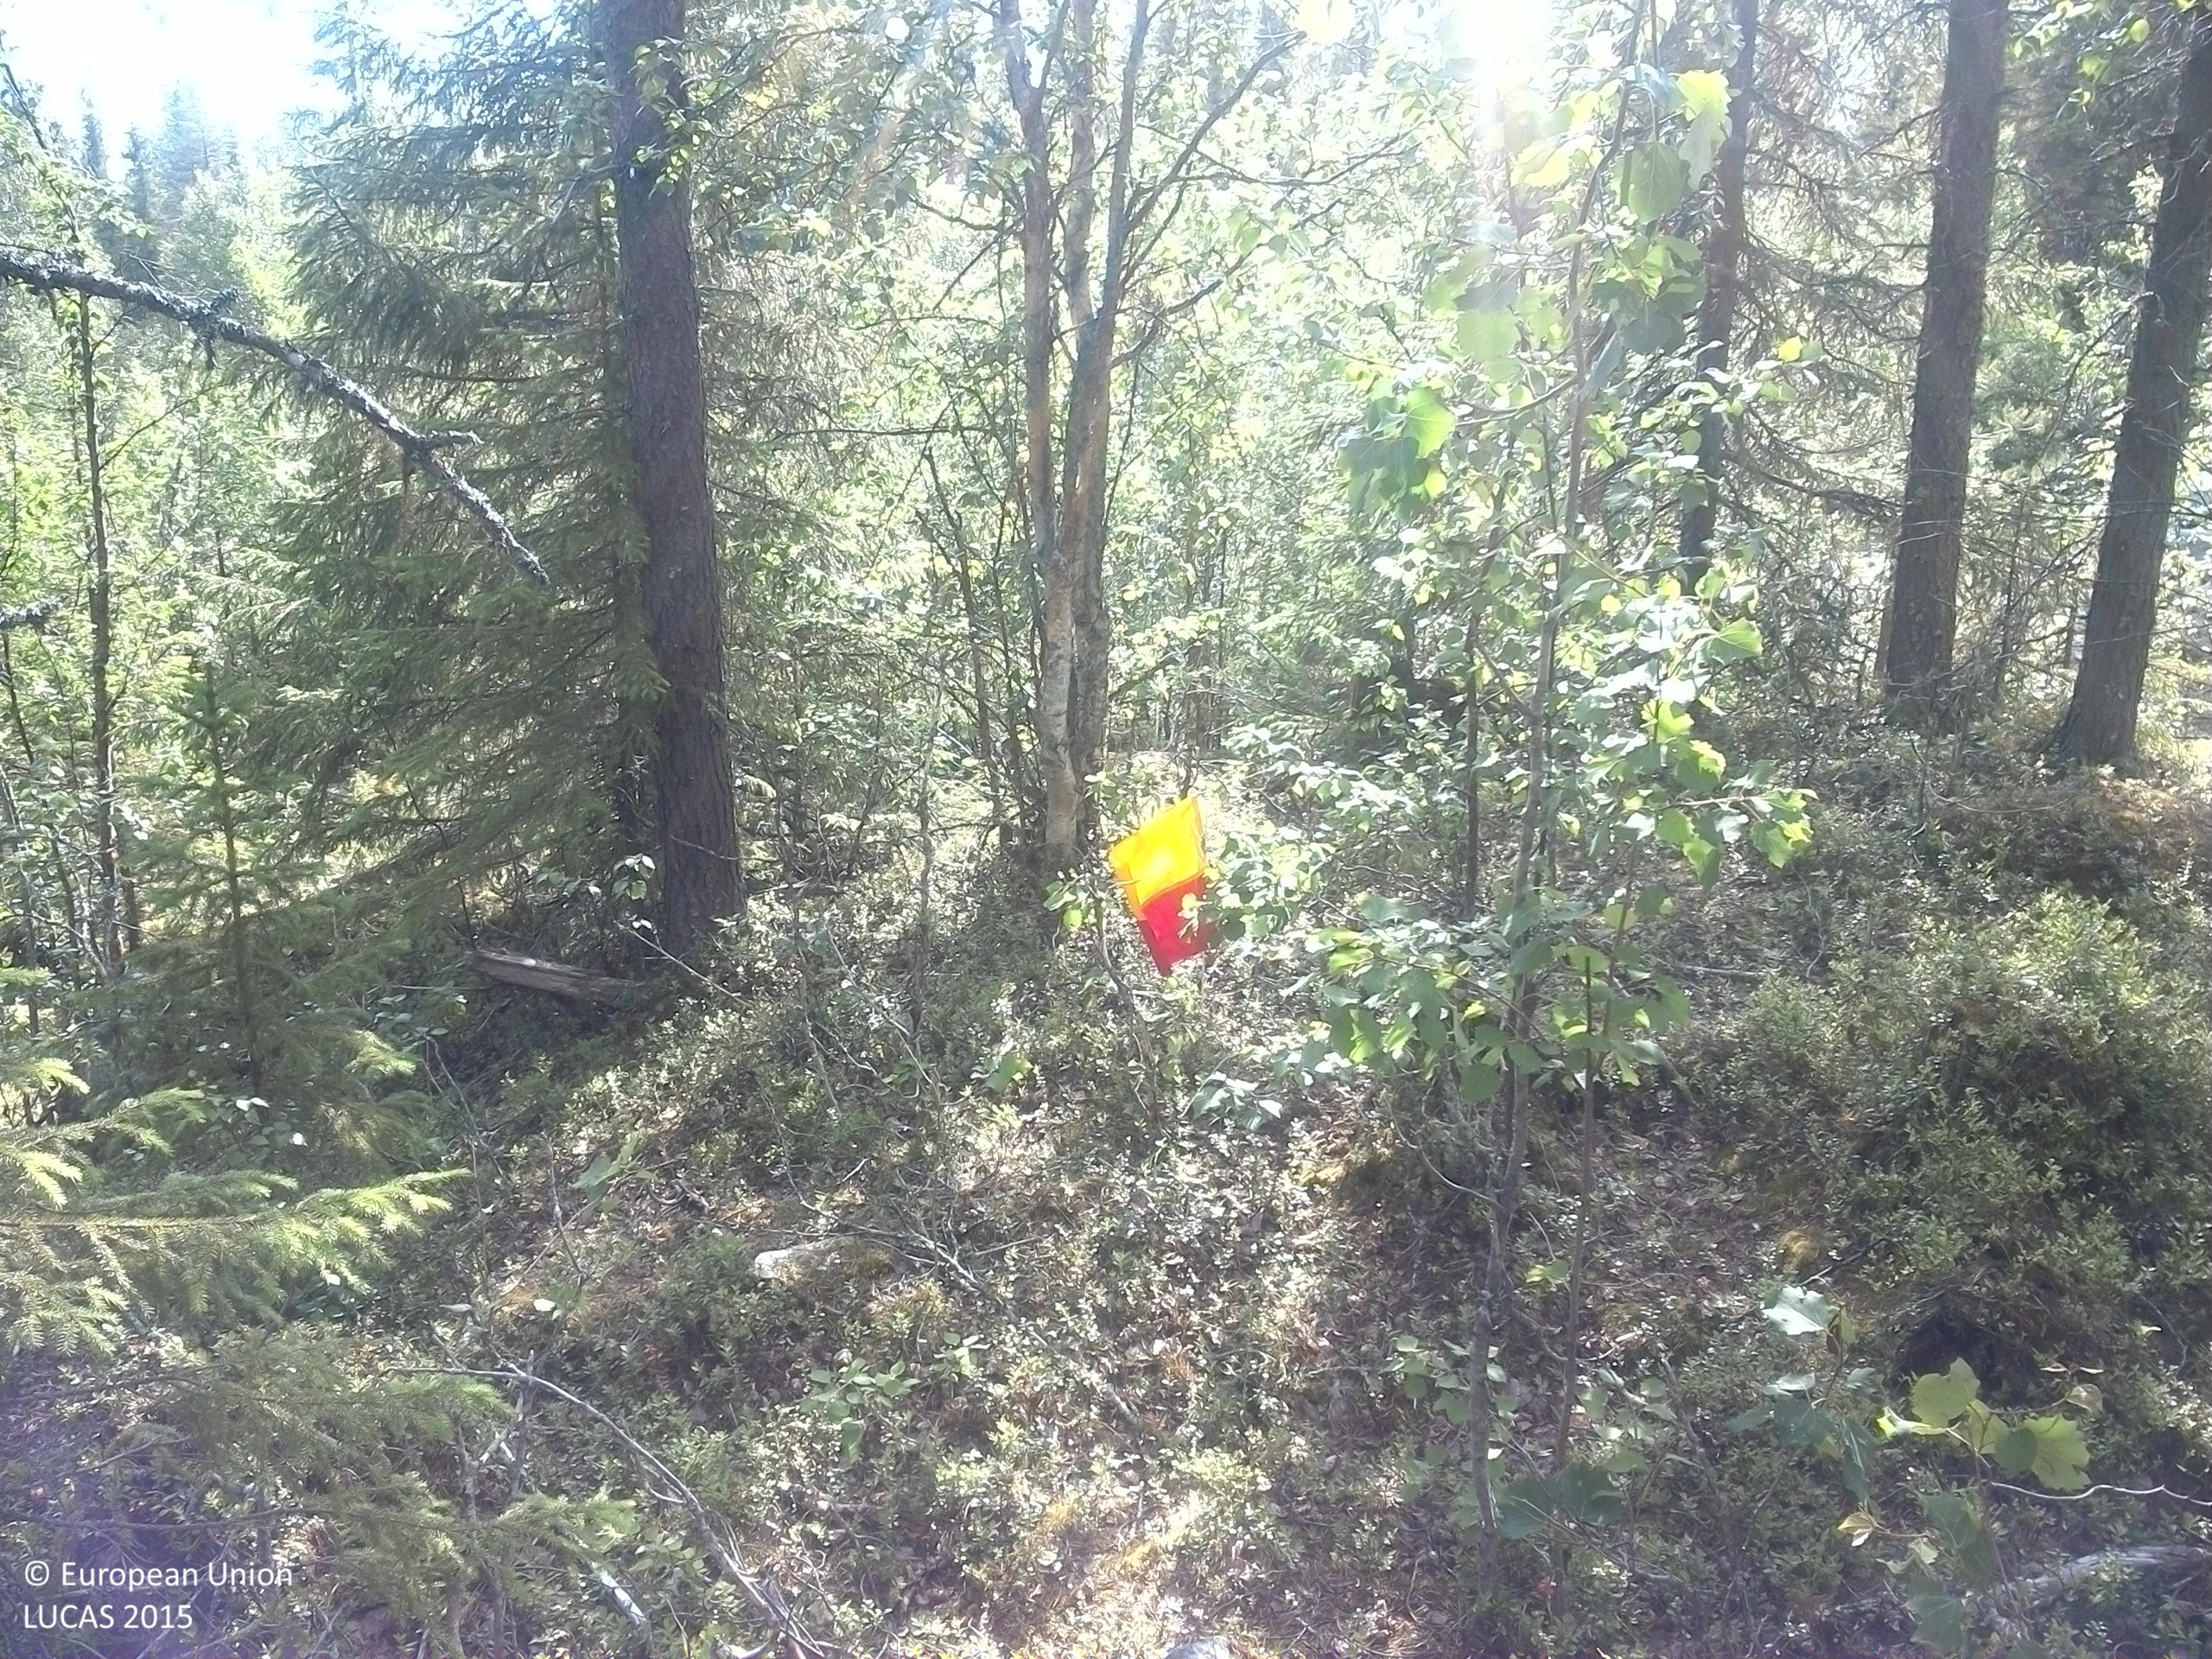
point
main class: Woodland
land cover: Other coniferous woodland
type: boreal forest
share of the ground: 50 - 75 %
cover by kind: coniferous forest trees 50 %, shrubs 25 %, broadleaved forest trees 10 %, lichens and mosses 10 %, consolidated bare surface 5 %
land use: Forestry
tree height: > 5 m
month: July
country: SE
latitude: 64.7109
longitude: 15.7379
